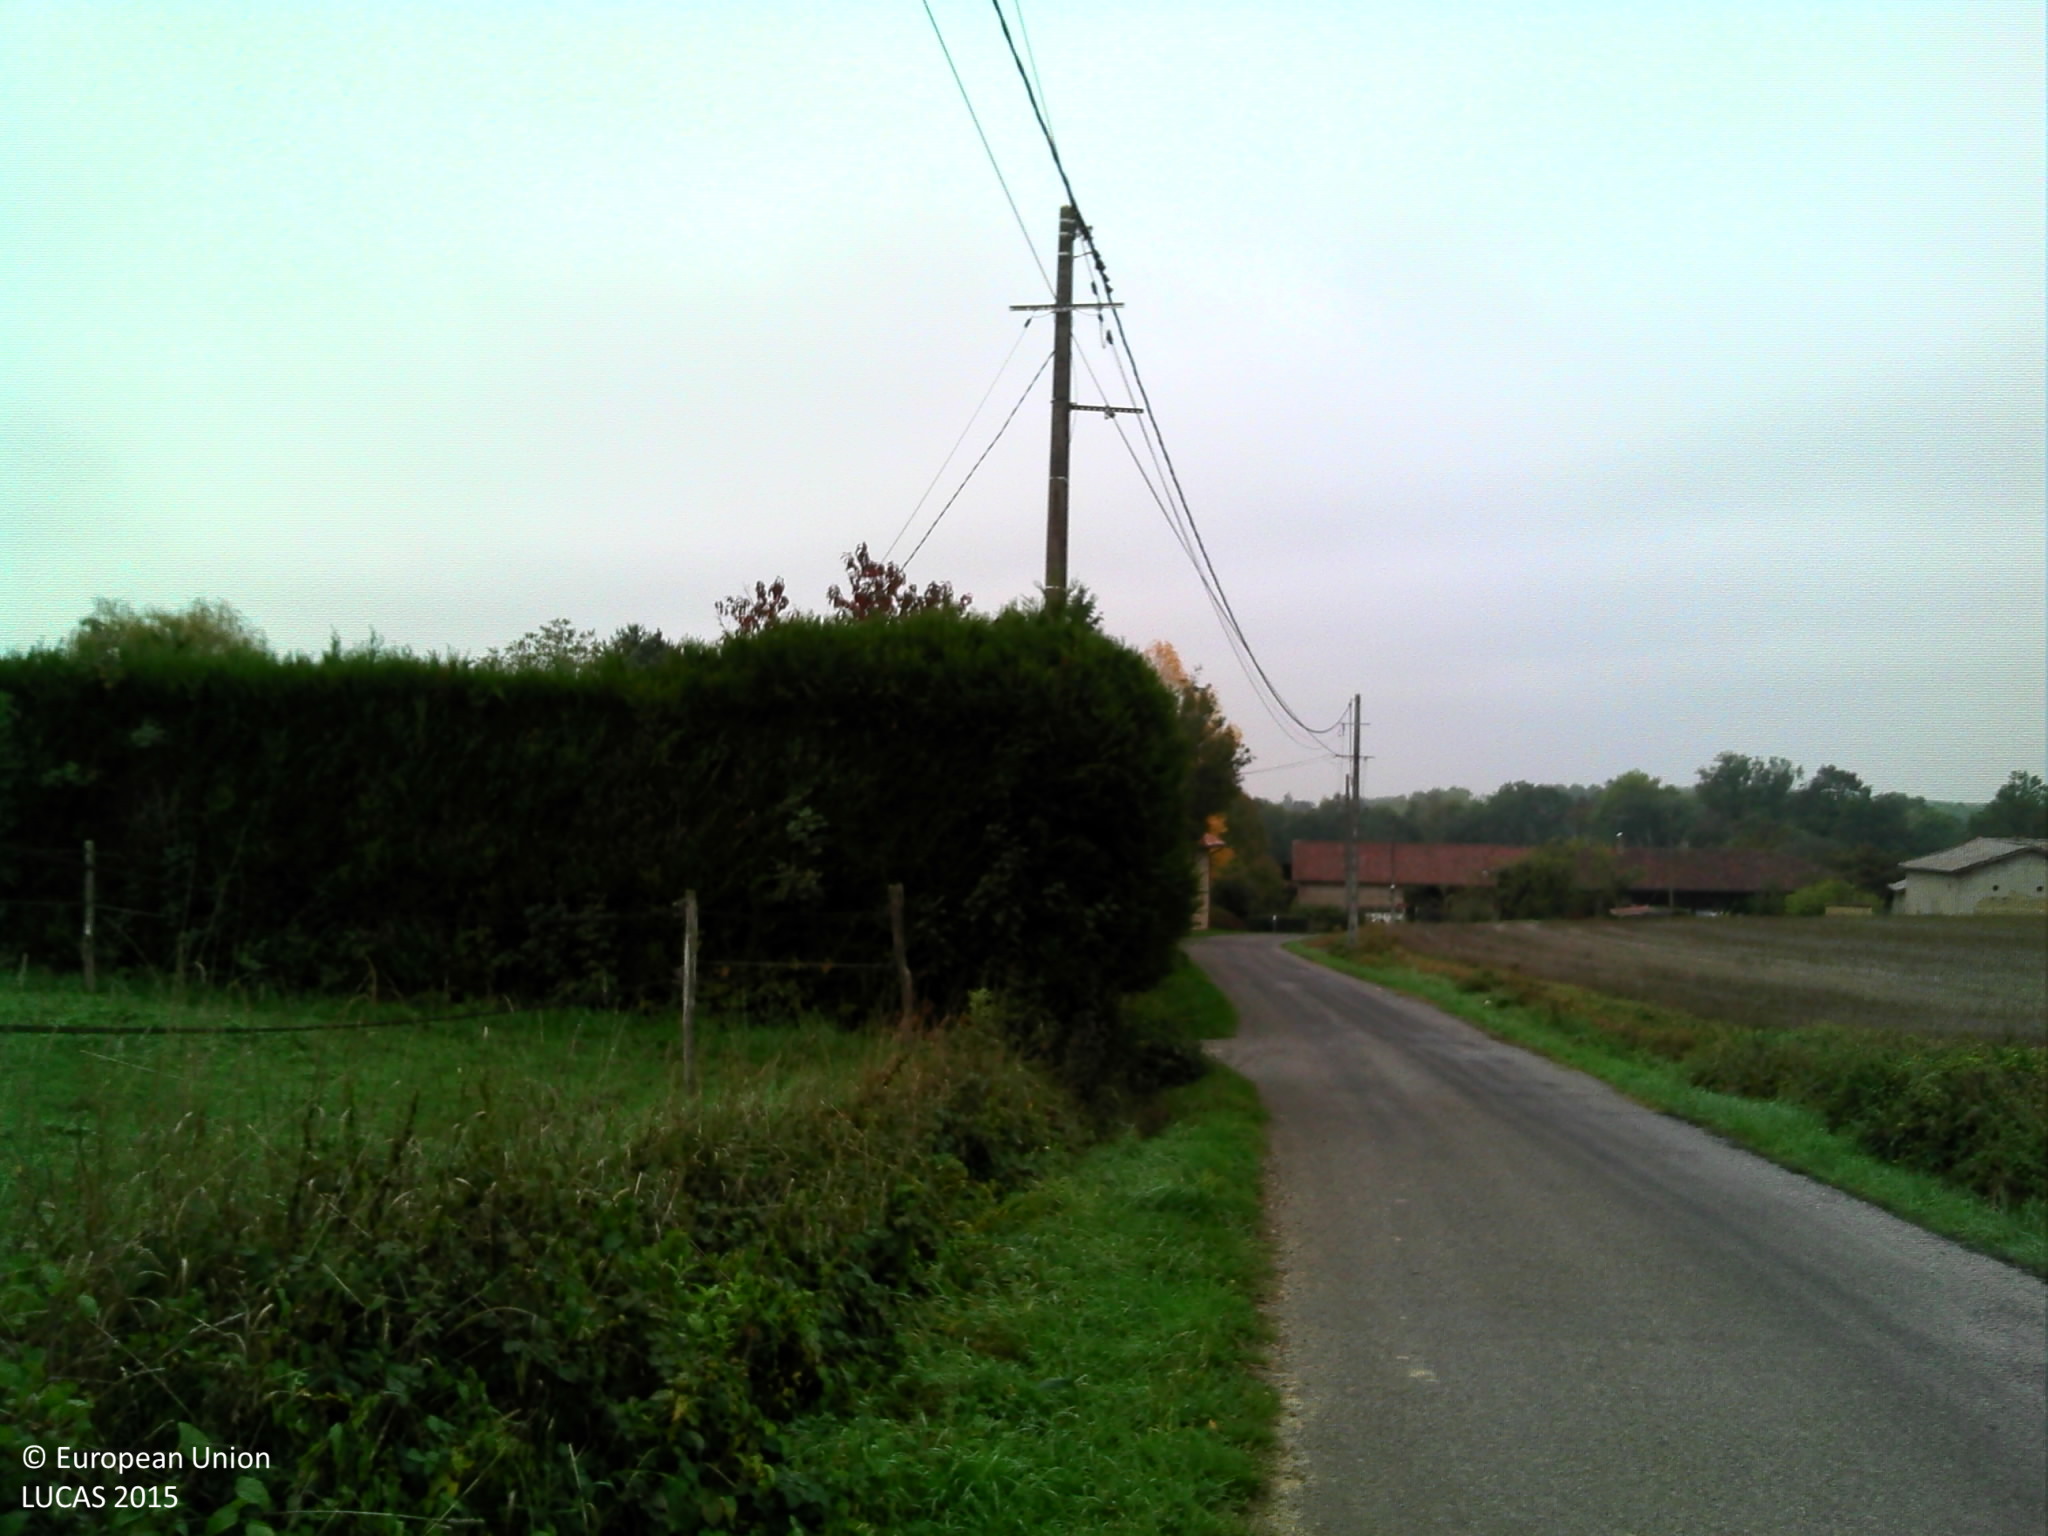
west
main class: Grassland
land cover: Grassland without tree/shrub cover
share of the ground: > 75 %
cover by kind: herbaceous plants 100 %
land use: Agriculture (excluding fallow land and kitchen gardens)
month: October
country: FR
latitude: 46.2503
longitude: 4.9569
